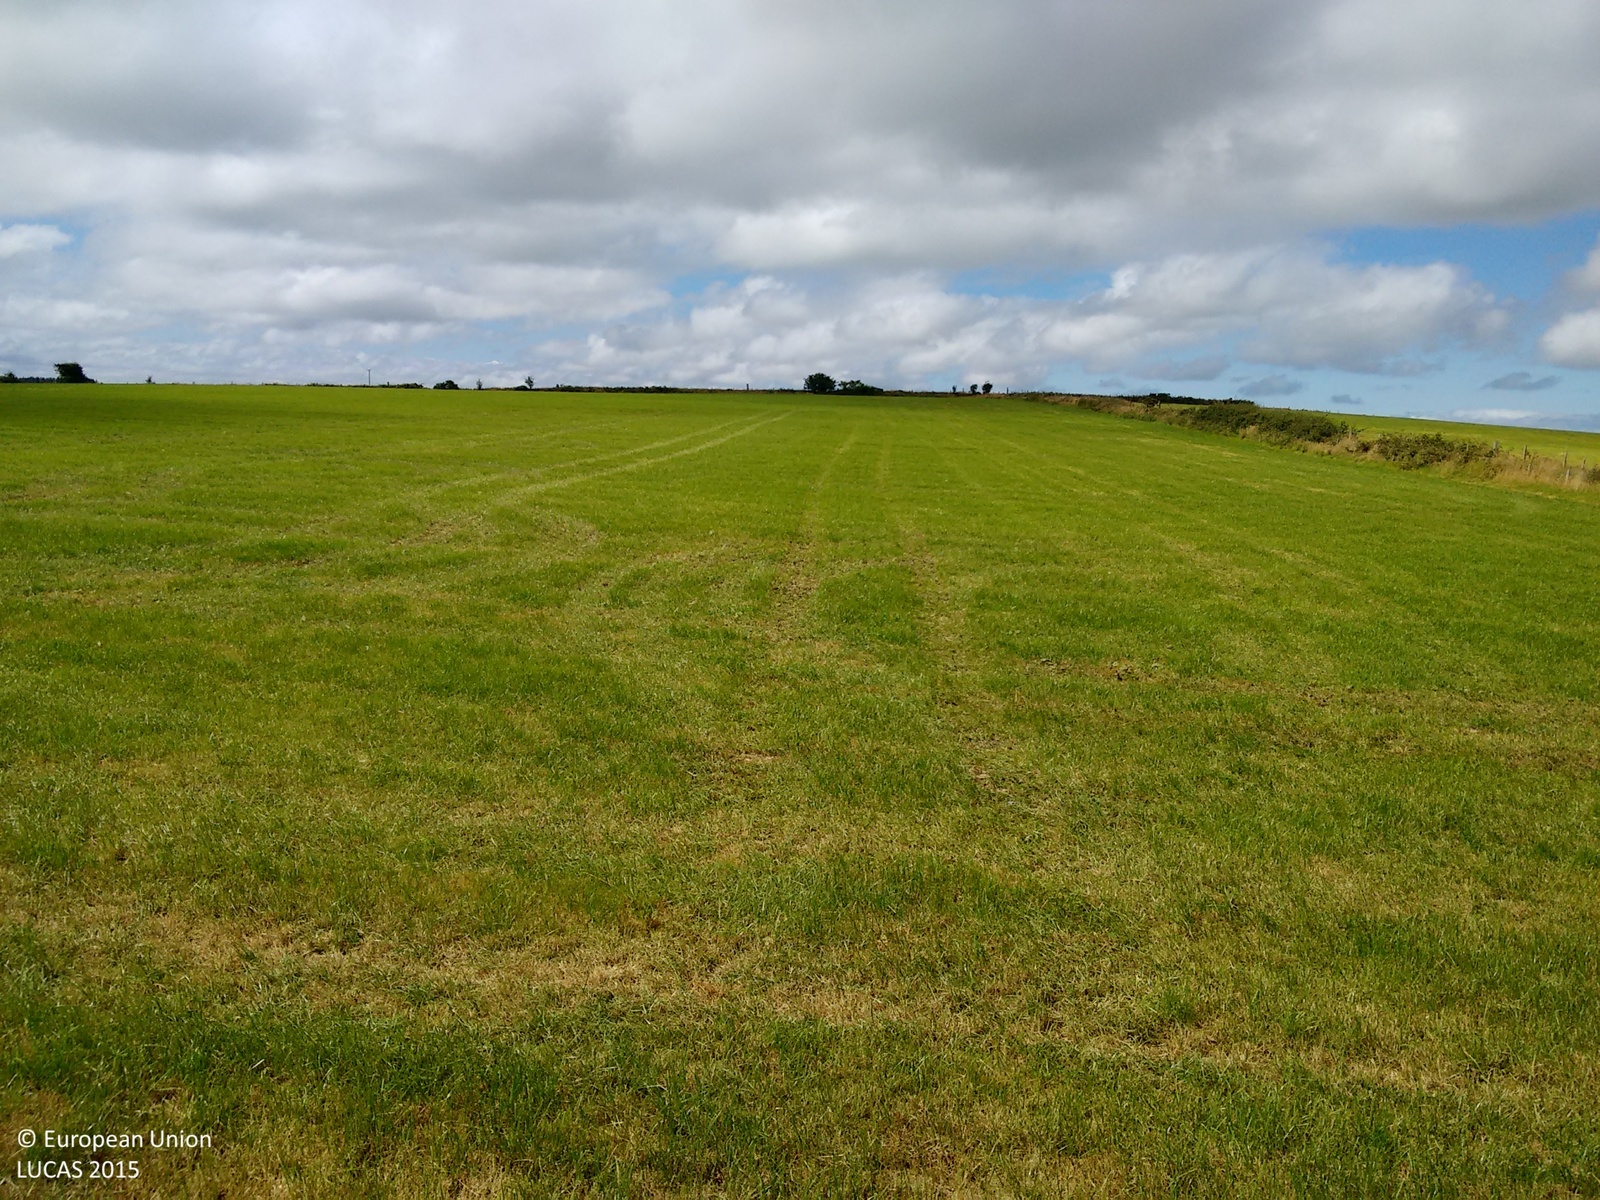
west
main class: Grassland
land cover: Grassland without tree/shrub cover
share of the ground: > 75 %
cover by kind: herbaceous plants 100 %
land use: Agriculture (excluding fallow land and kitchen gardens)
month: August
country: GB
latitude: 52.1638
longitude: -4.2964
